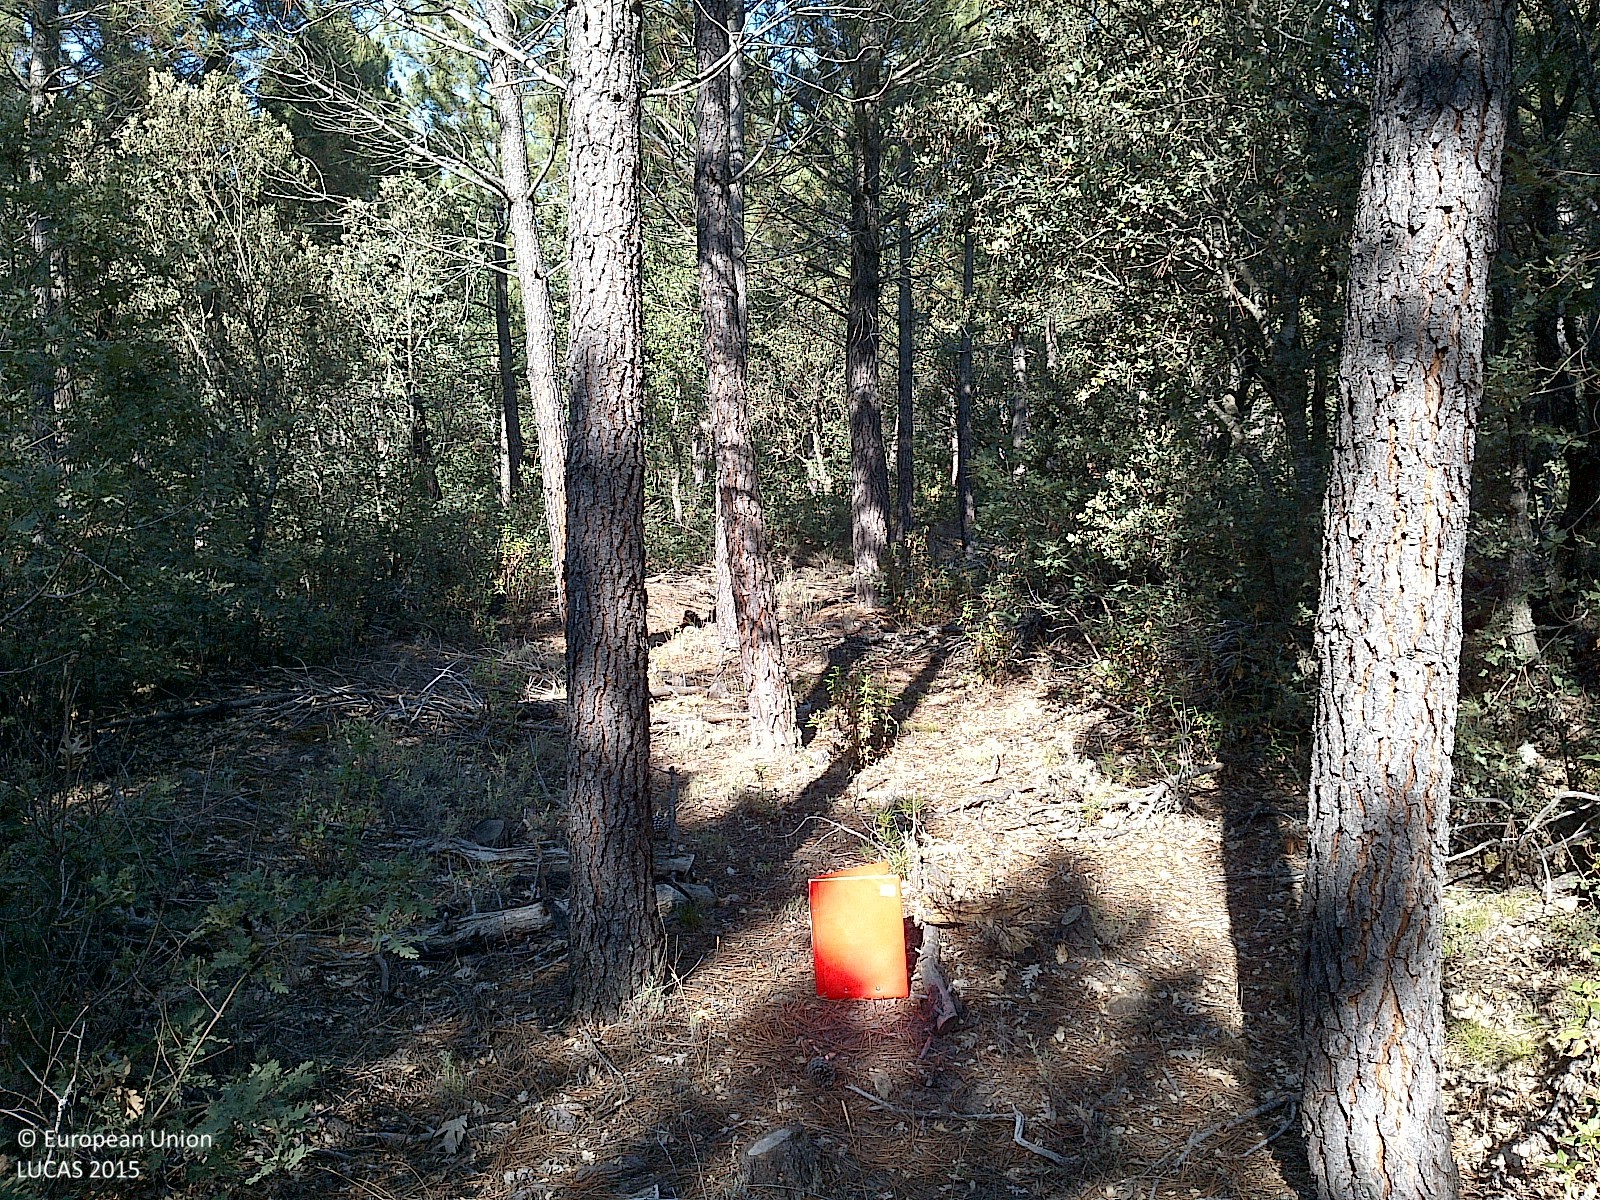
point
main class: Woodland
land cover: Pine dominated coniferous woodland
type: coniferous forest of the mediterranean region
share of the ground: > 75 %
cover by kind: coniferous forest trees 80 %, shrubs 10 %, herbaceous plants 5 %, unconsolidated bare surface 5 %
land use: Forestry
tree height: > 5 m
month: July
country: ES
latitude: 41.8210
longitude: -2.0612
